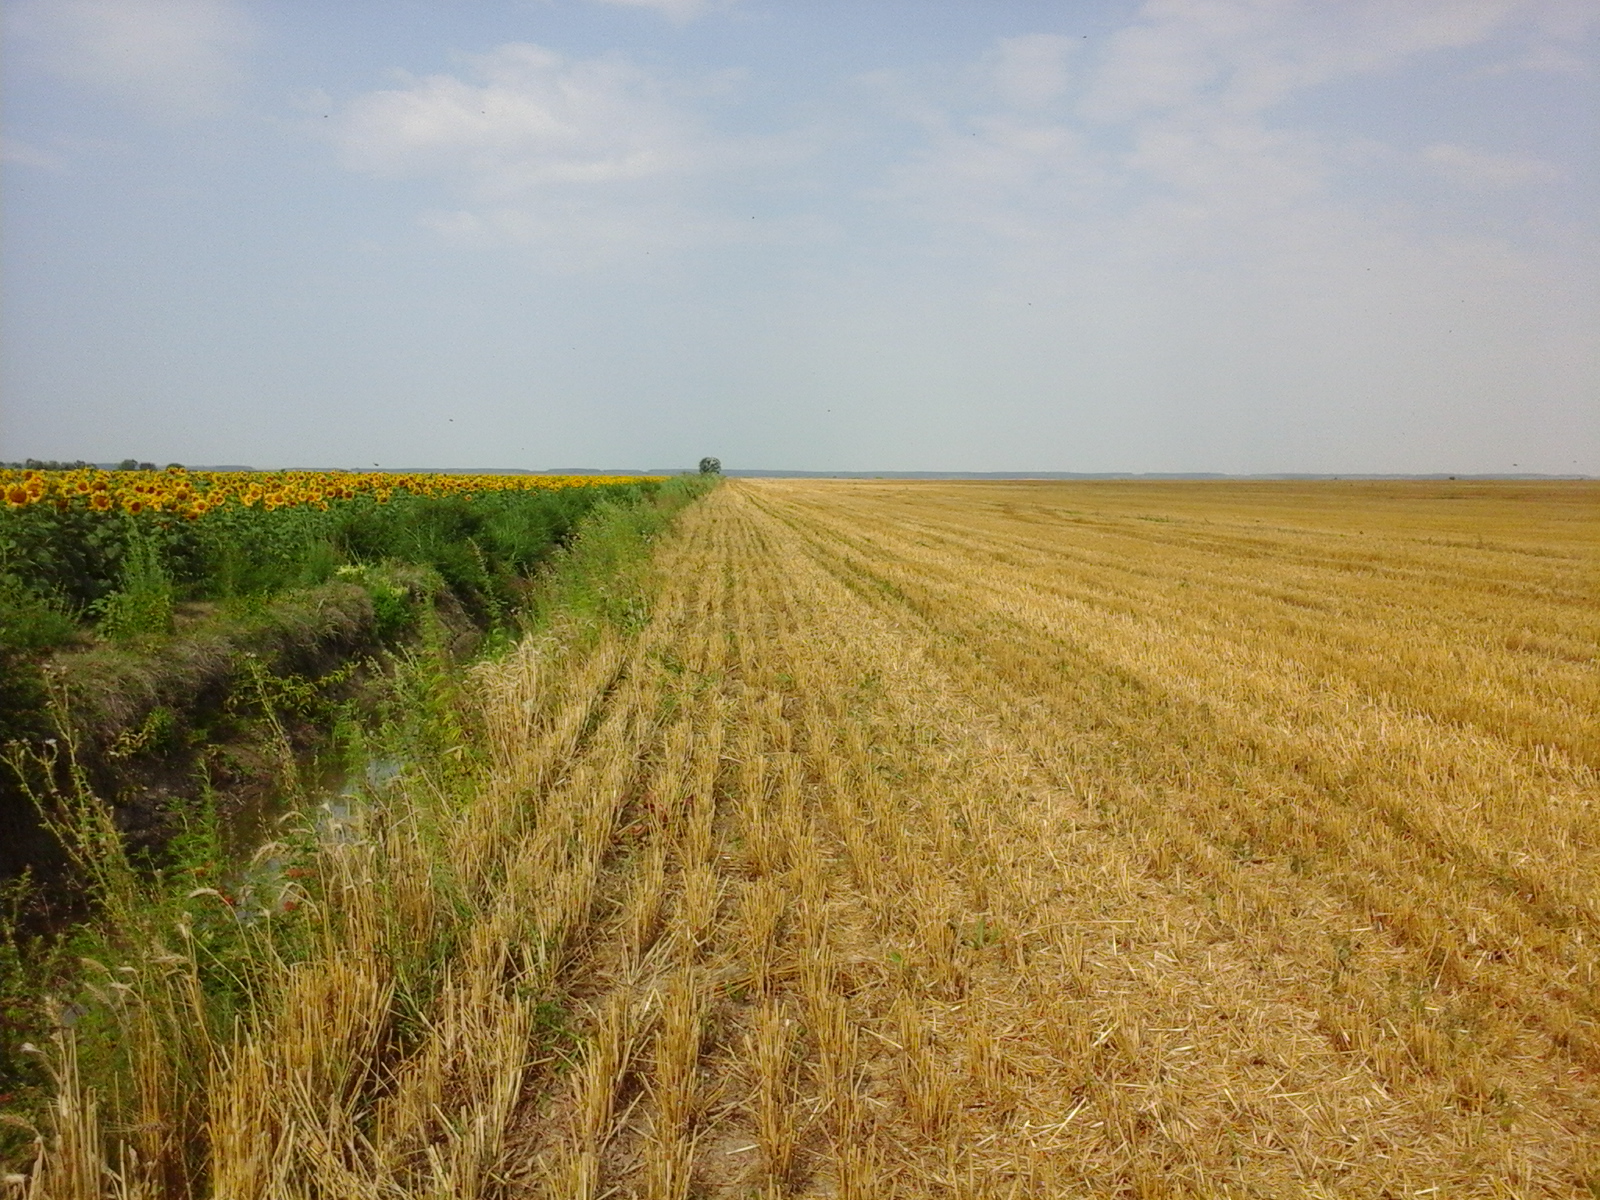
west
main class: Cropland
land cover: Sunflower
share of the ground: > 75 %
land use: Agriculture (excluding fallow land and kitchen gardens)
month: July
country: RO
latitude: 44.4895
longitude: 28.0273
